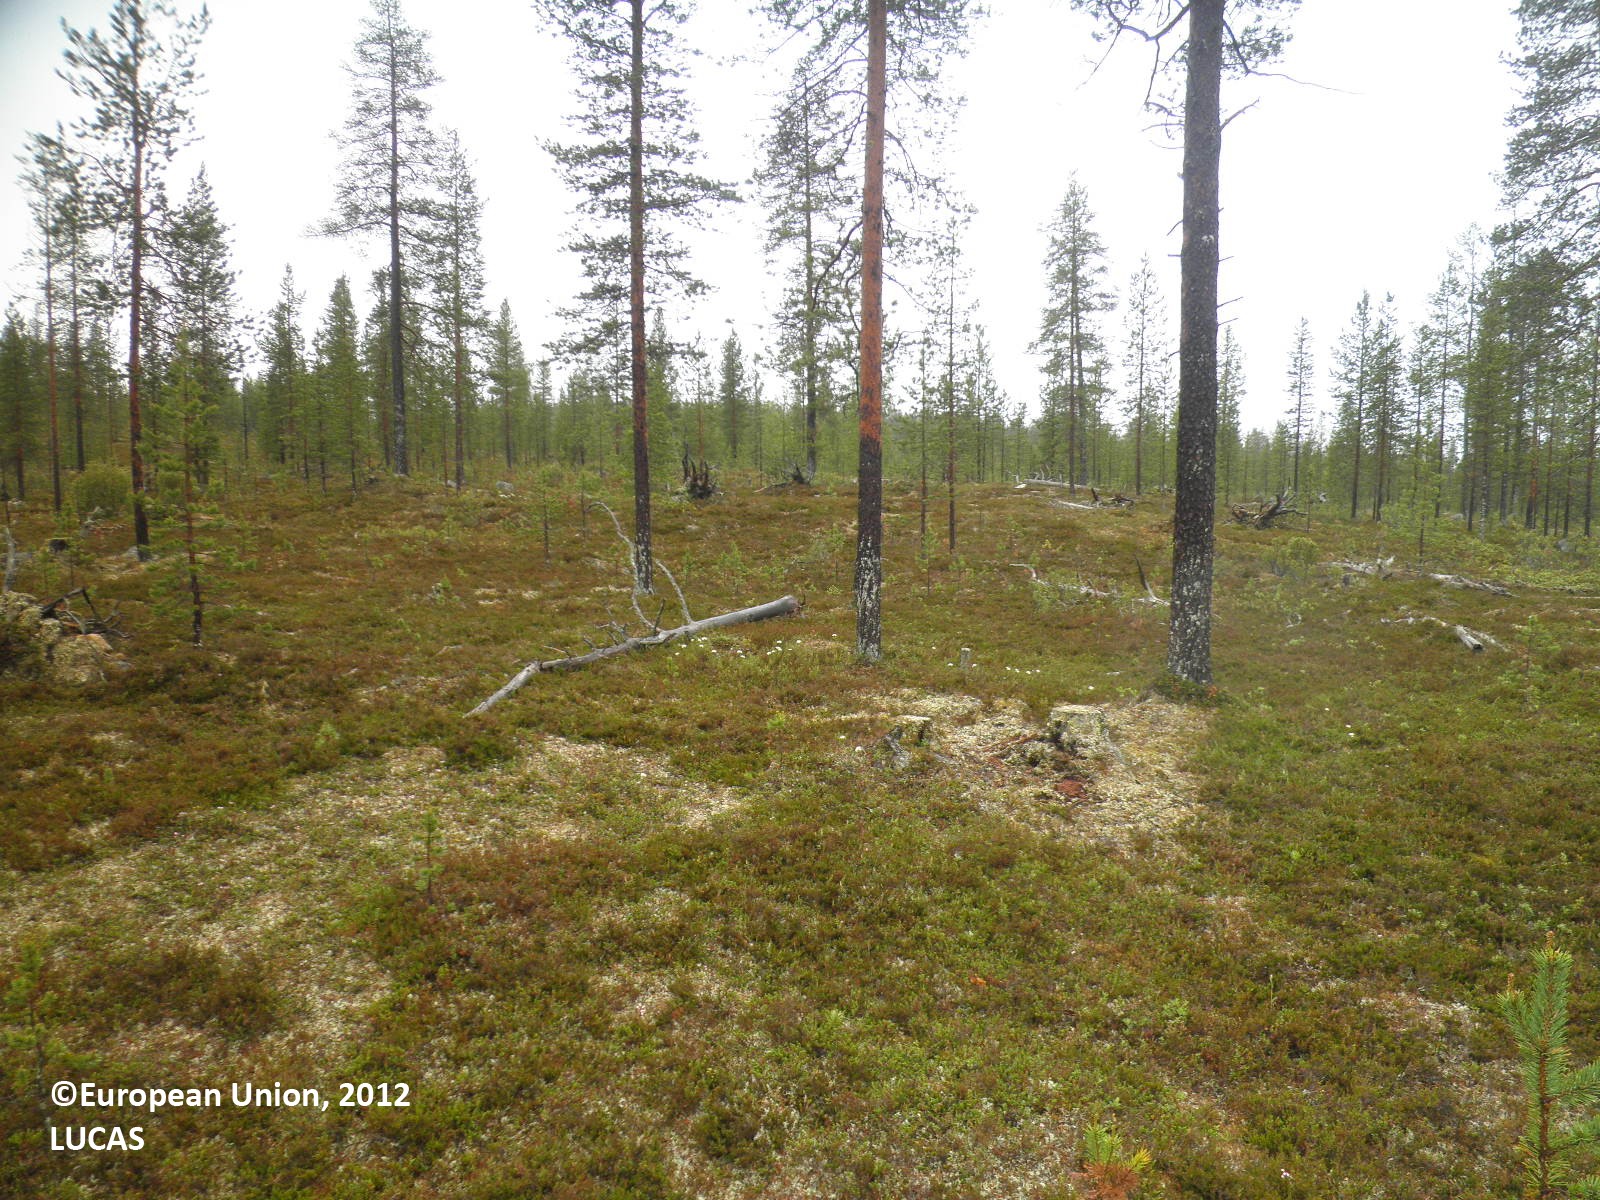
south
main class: Woodland
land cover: Pine dominated coniferous woodland
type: boreal forest
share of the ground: 25 - 50 %
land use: Forestry
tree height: > 5 m
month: June
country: FI
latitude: 68.4806
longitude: 27.5982
